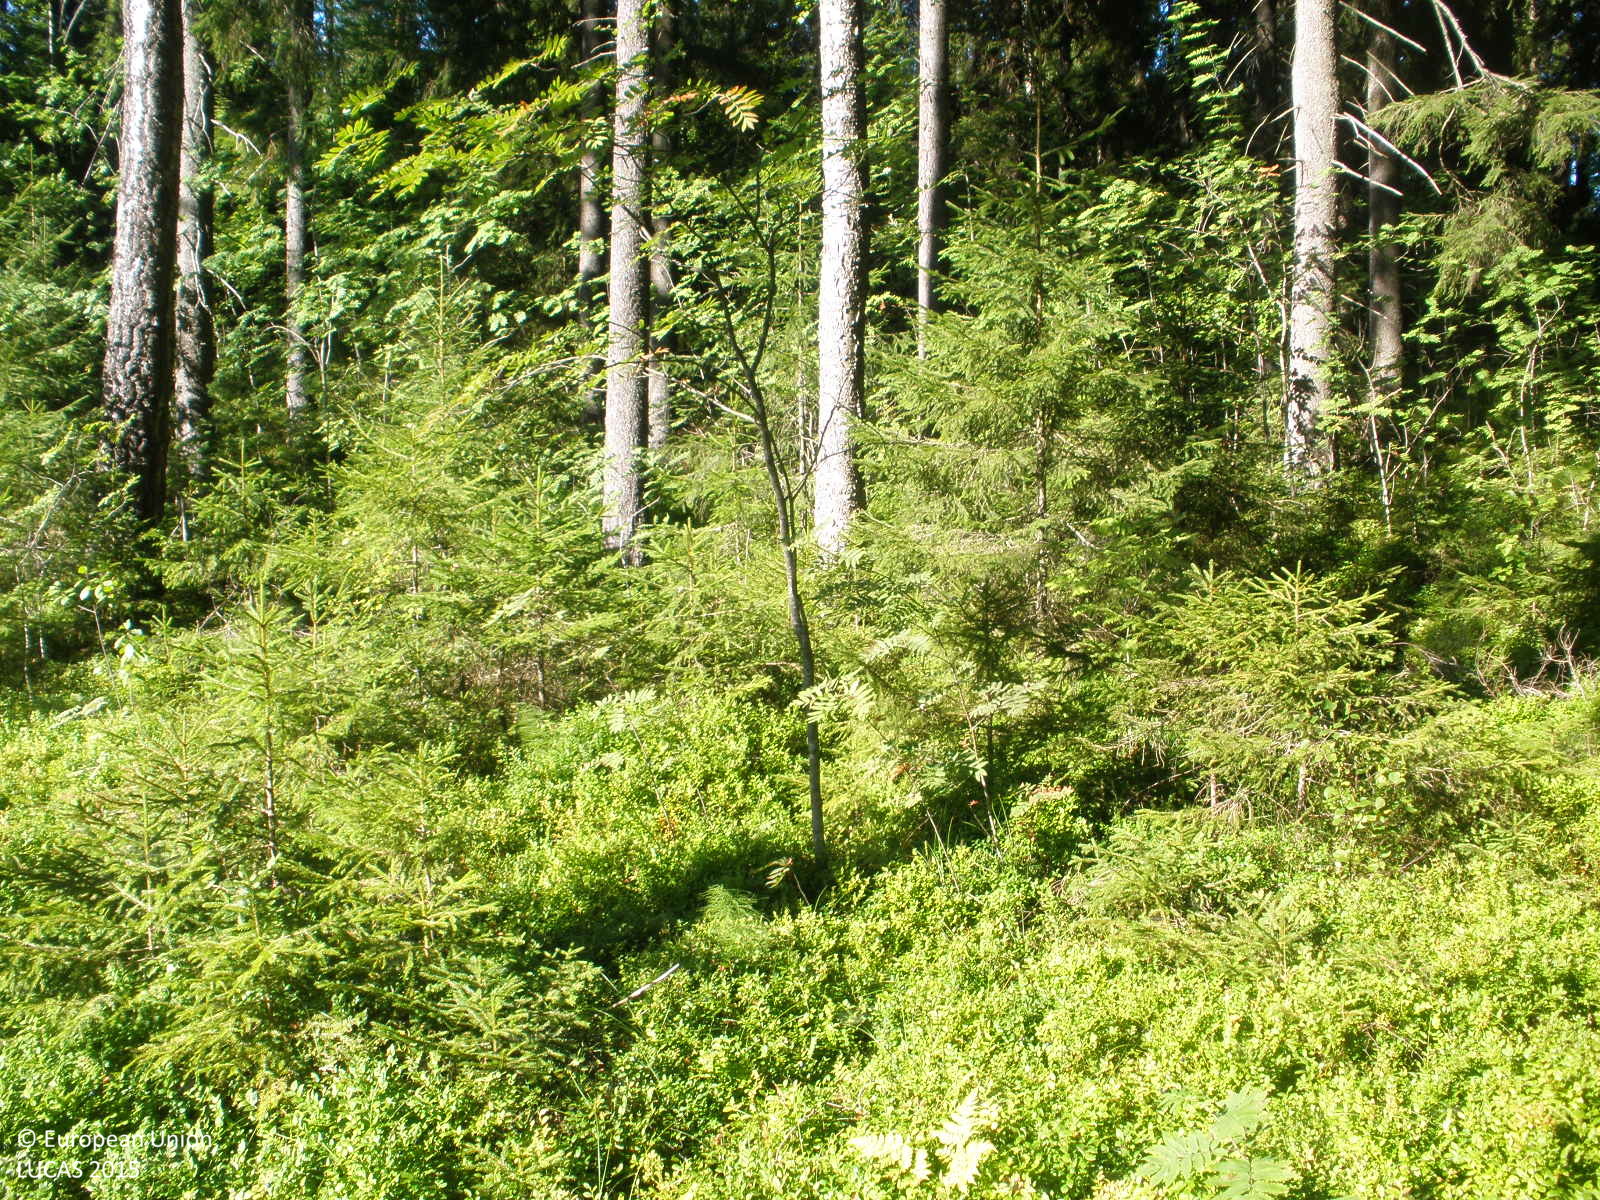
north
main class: Woodland
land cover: Spruce dominated coniferous woodland
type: boreal forest
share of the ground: > 75 %
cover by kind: coniferous forest trees 75 %, herbaceous plants 15 %, shrubs 5 %, lichens and mosses 5 %
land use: Forestry
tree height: > 5 m
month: August
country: FI
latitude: 60.5650
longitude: 23.9402
